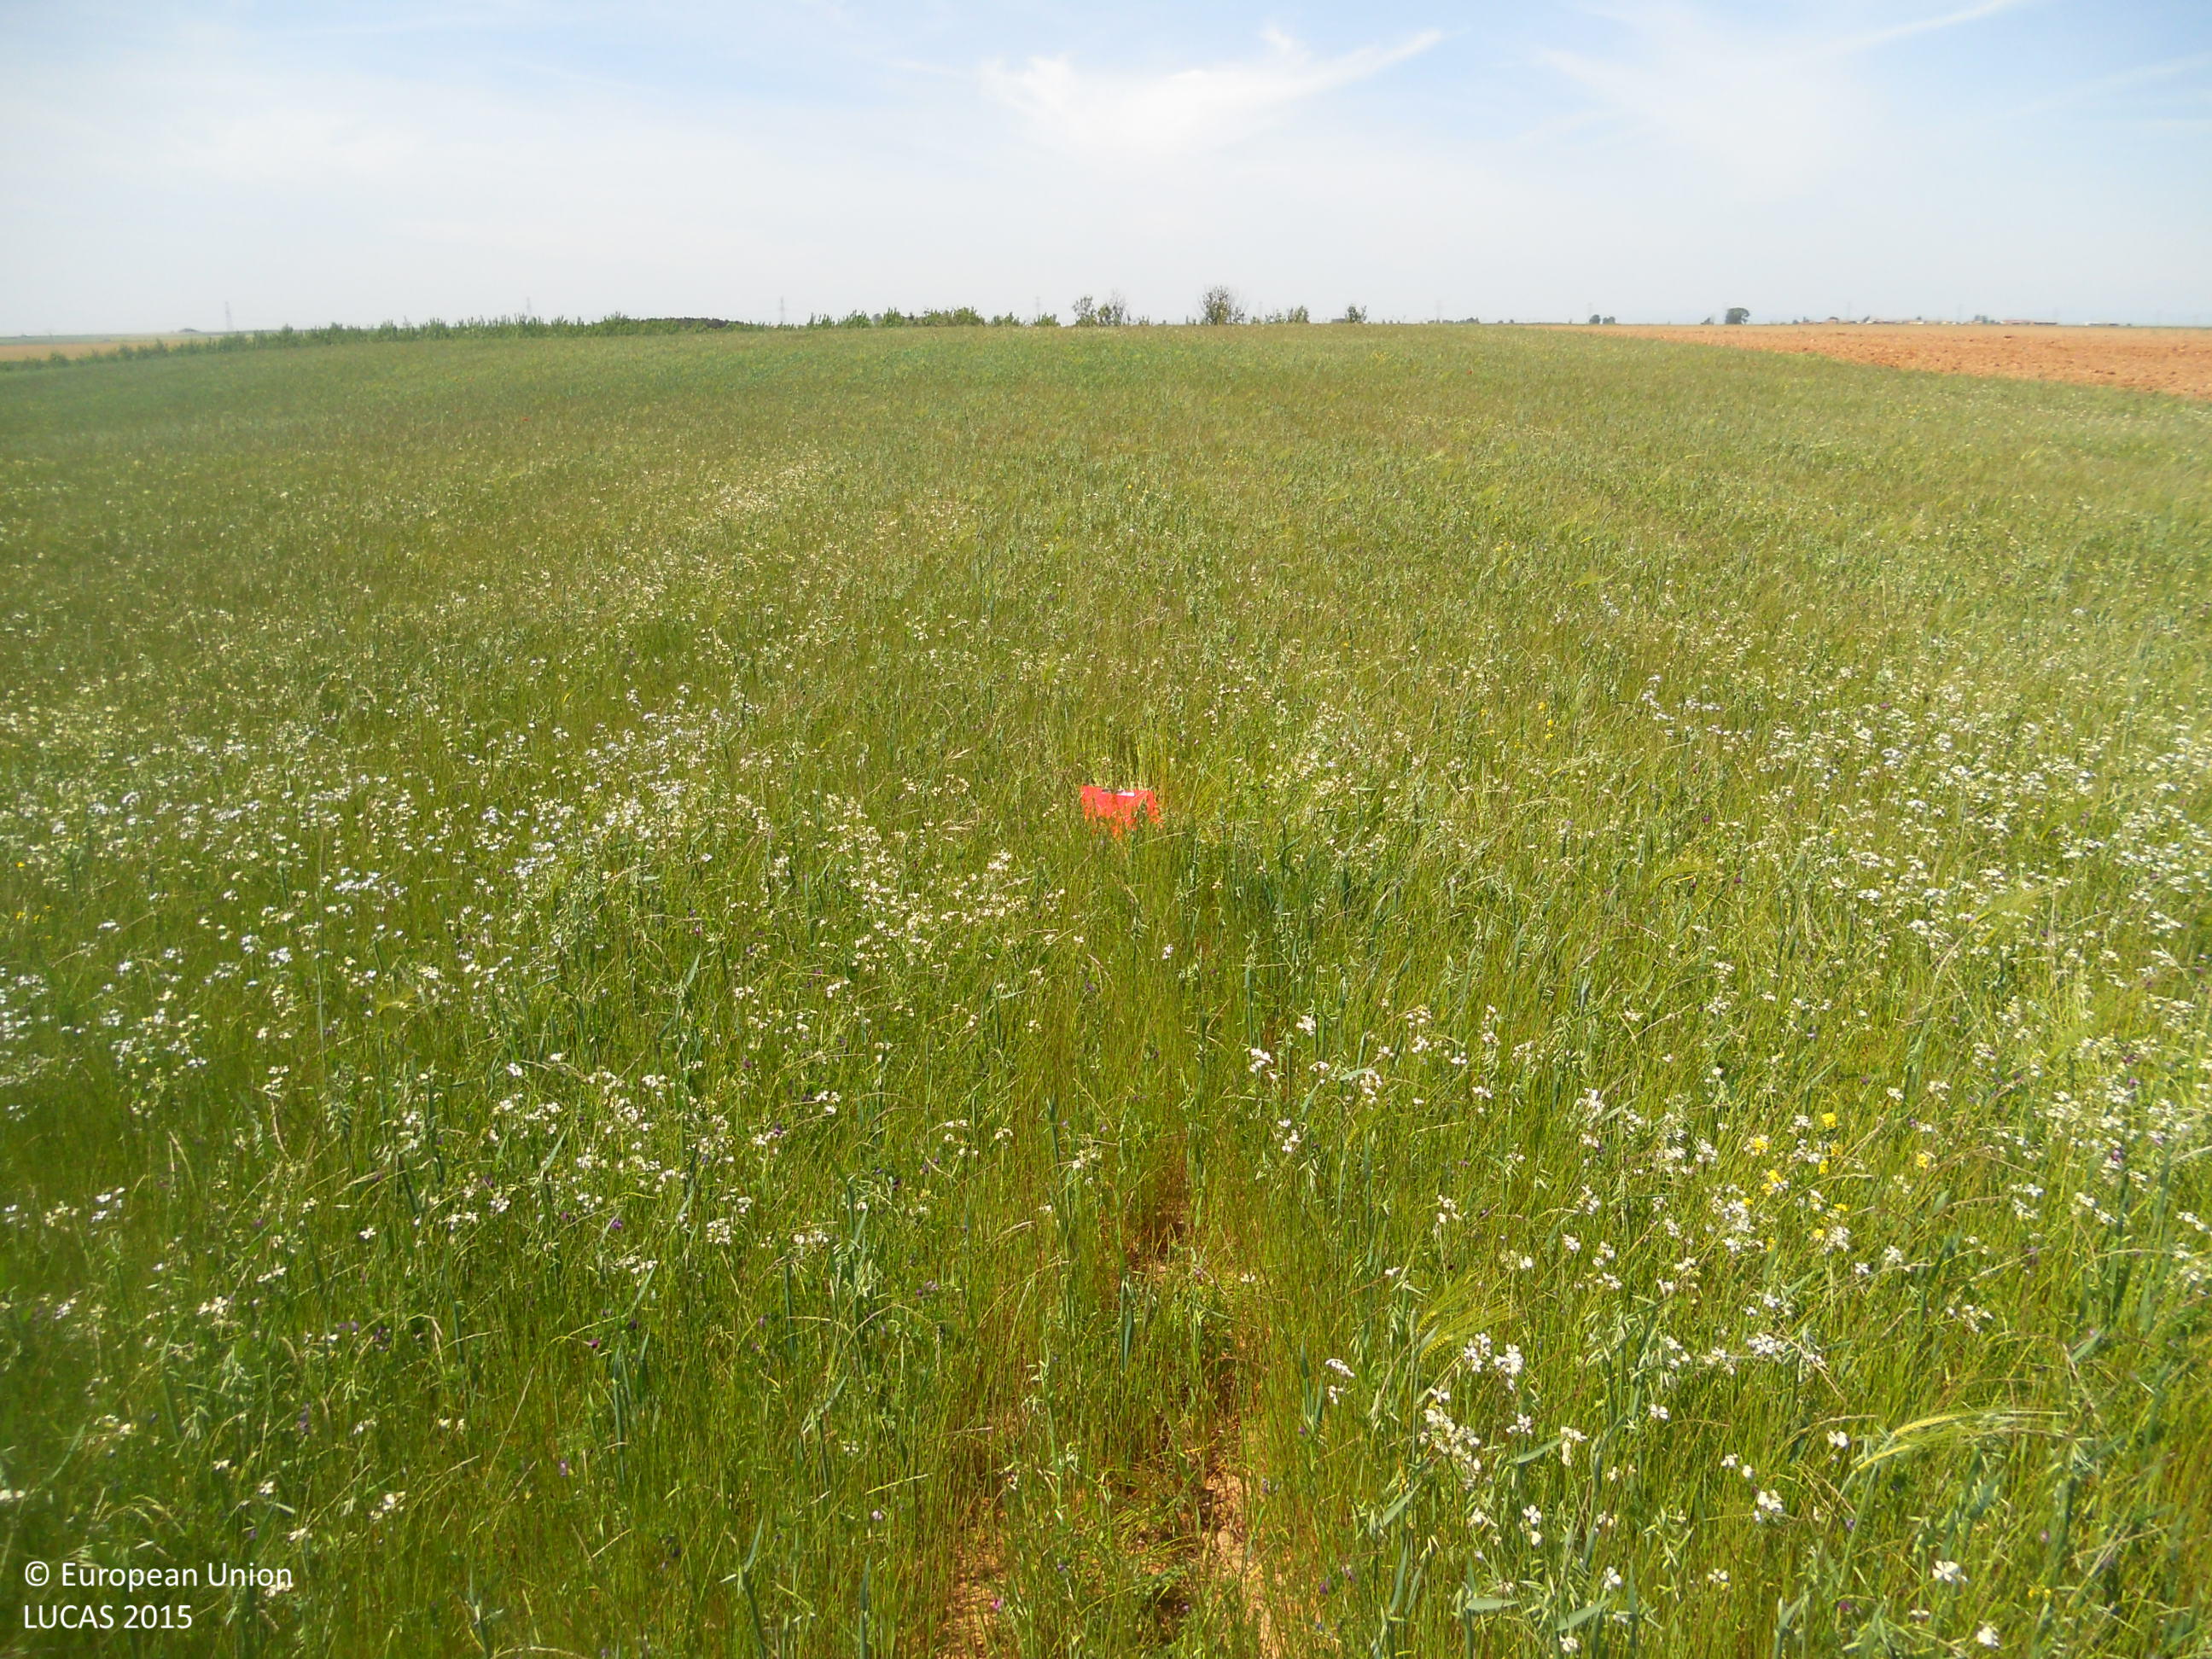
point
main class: Cropland
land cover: Mixed cereals for fodder
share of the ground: > 75 %
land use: Agriculture (excluding fallow land and kitchen gardens)
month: May
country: ES
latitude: 42.3815
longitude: -5.3076
